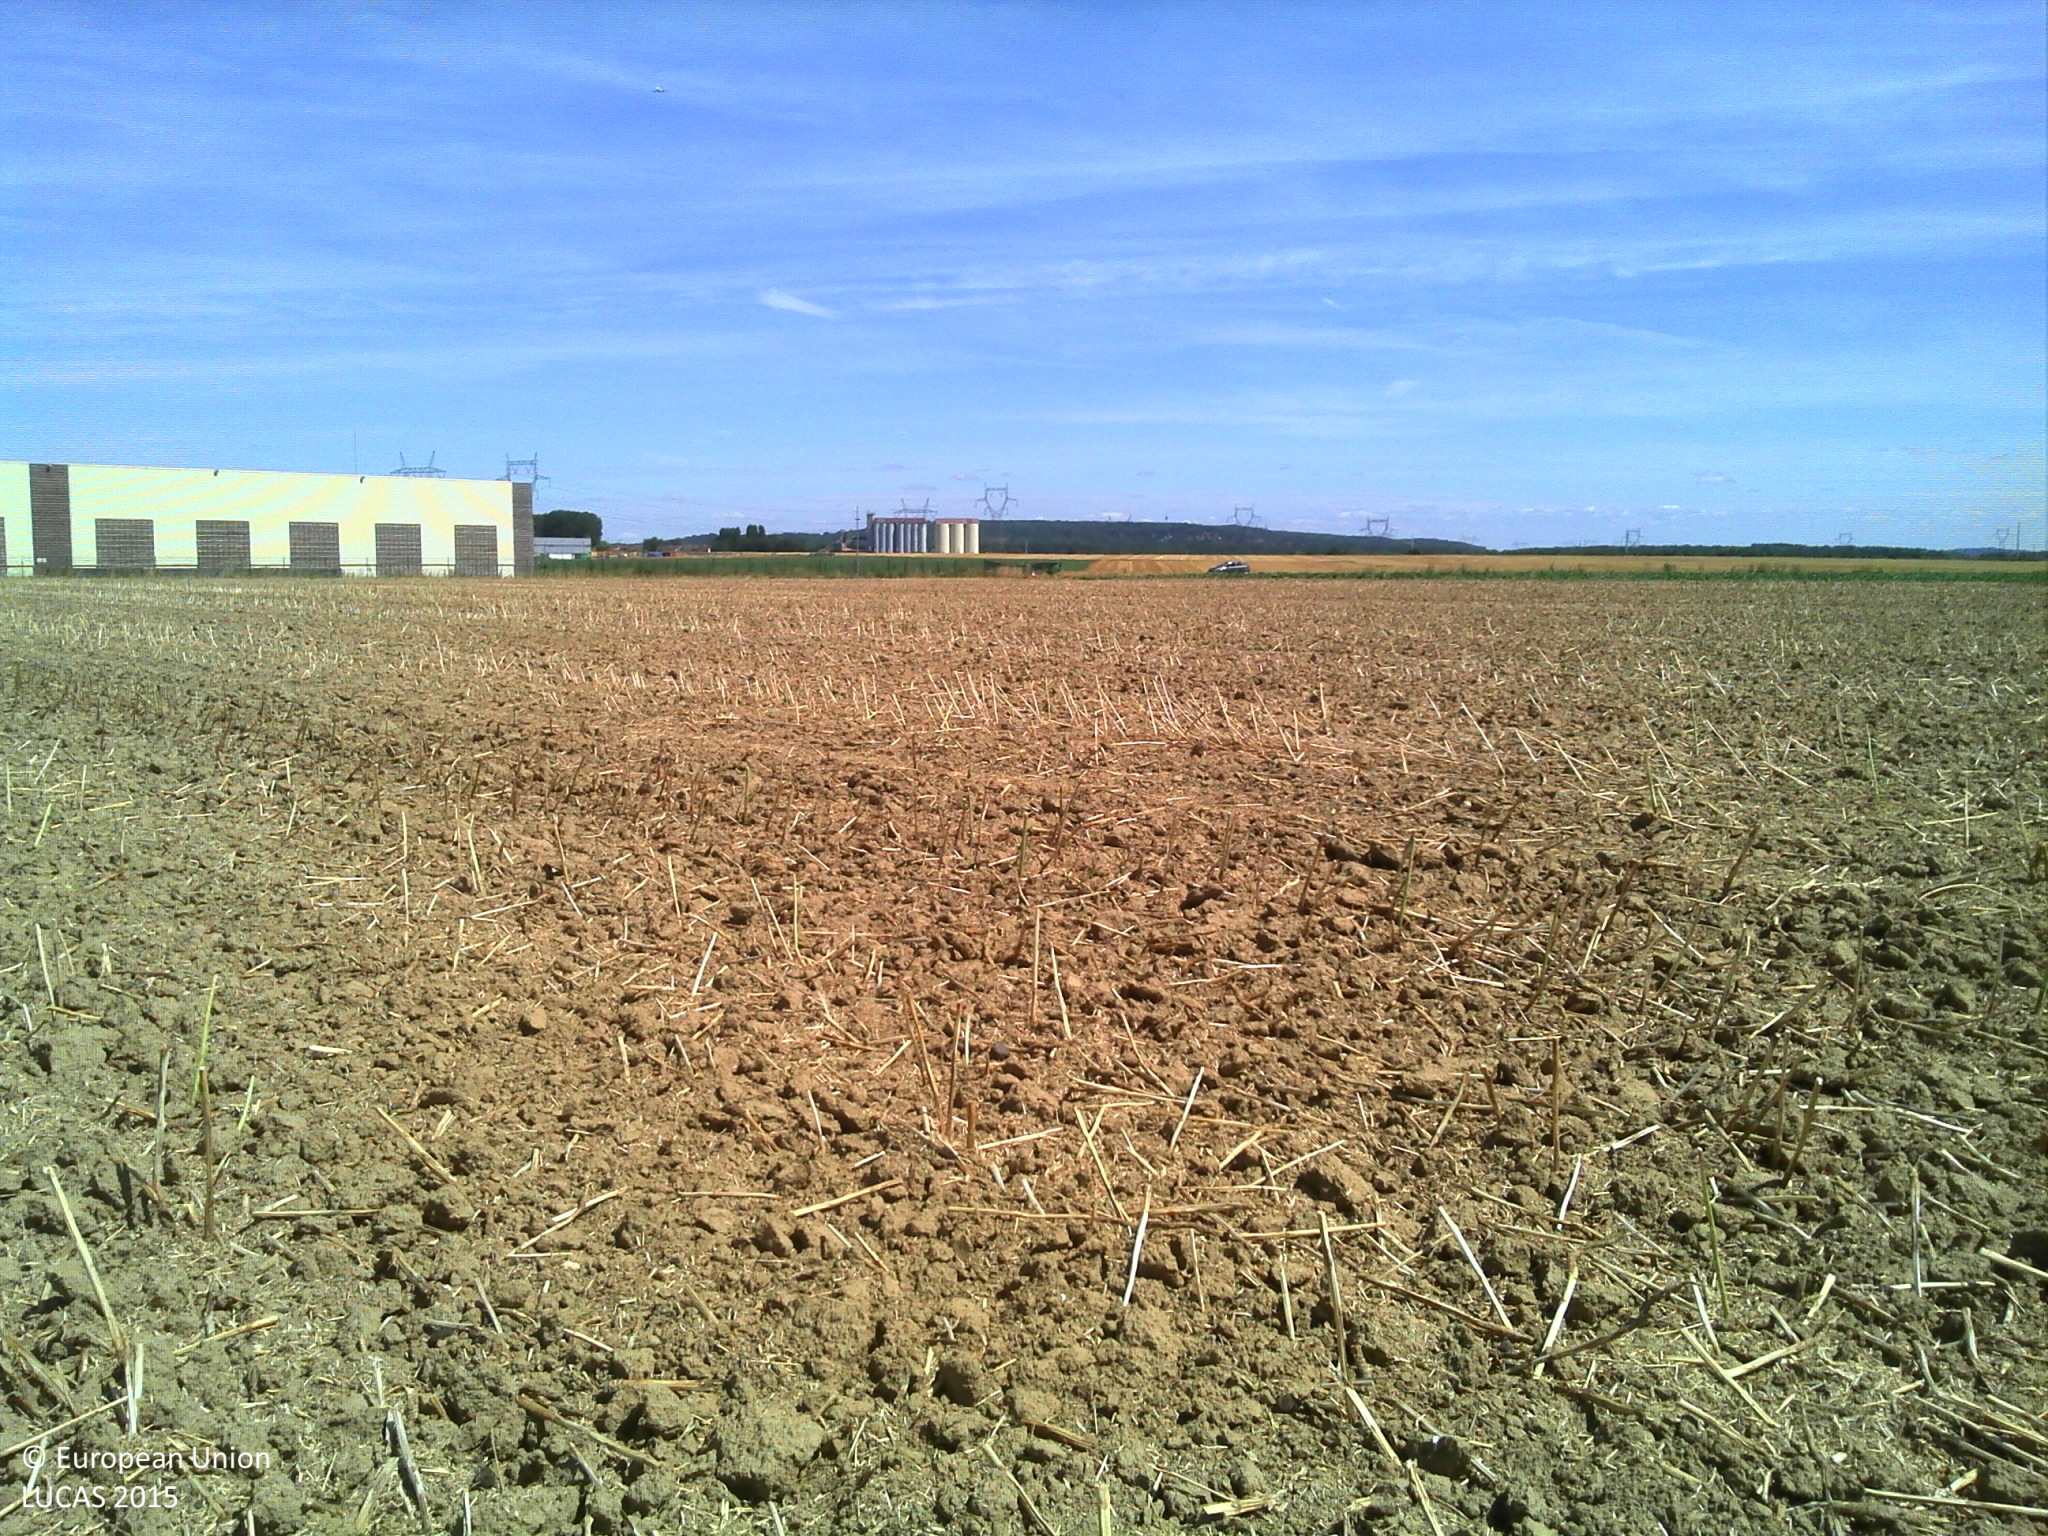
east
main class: Cropland
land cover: Rape and turnip rape
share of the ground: > 75 %
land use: Agriculture (excluding fallow land and kitchen gardens)
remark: Harvested field
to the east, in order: Rape and turnip rape; Sugar beet; Grass margins; Tracks; Grass margins; Common wheat
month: August
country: FR
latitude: 49.0273
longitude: 2.6726
